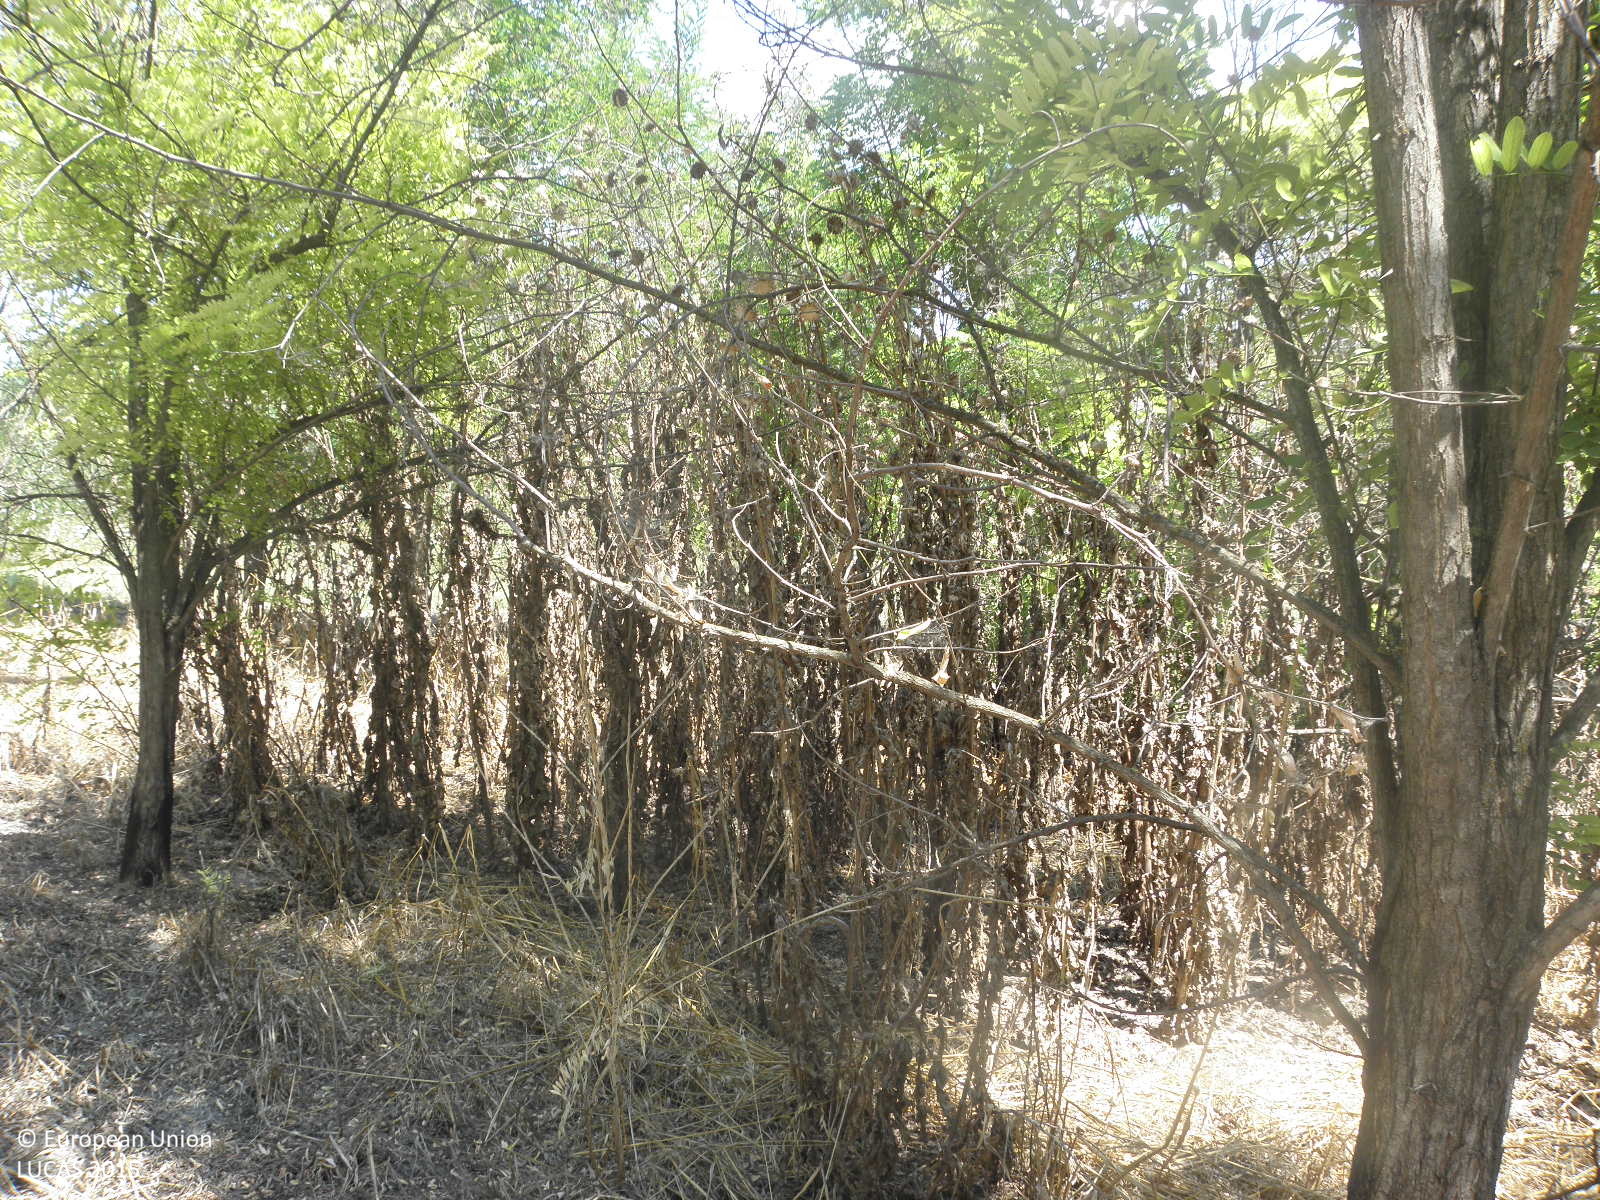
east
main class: Woodland
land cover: Broadleaved woodland
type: thermophilous deciduous forest
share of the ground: > 75 %
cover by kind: broadleaved forest trees 90 %, herbaceous plants 10 %
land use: Forestry
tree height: > 5 m
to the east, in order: Broadleaved woodland; Tracks; Broadleaved woodland; Grassland without tree/shrub cover; Rivers and streams; Shruby margins; Durum wheat
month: July
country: GR
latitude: 39.4100
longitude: 22.3553
